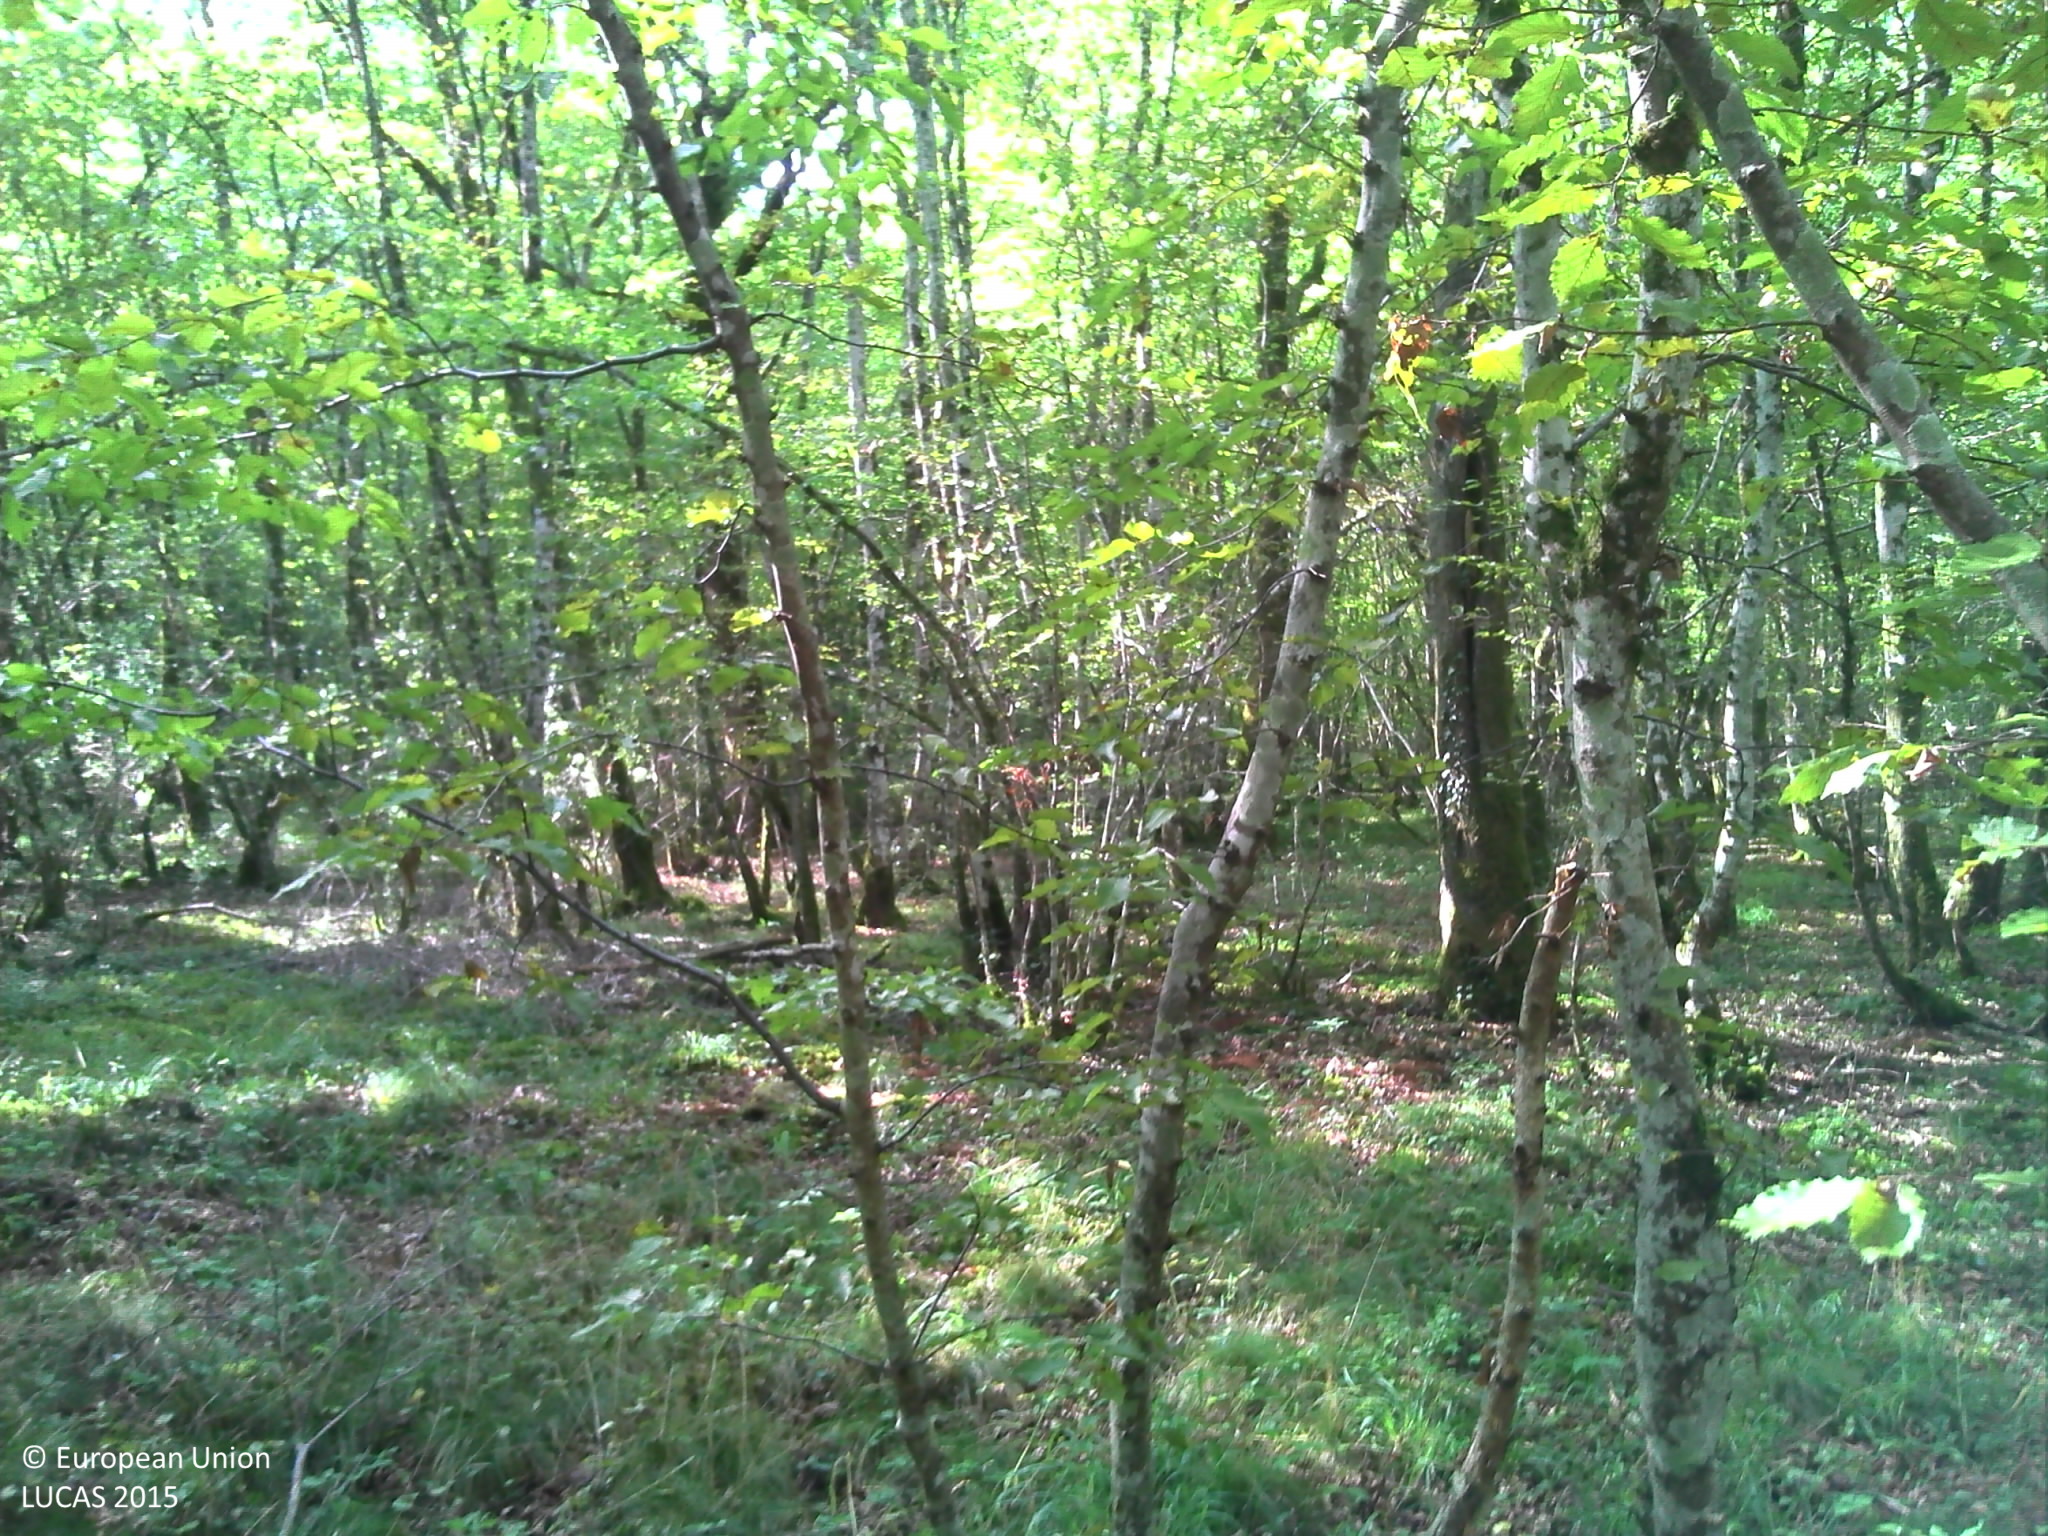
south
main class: Woodland
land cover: Broadleaved woodland
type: mesophytic deciduous forest
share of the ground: > 75 %
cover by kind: broadleaved forest trees 80 %, shrubs 10 %, herbaceous plants 10 %
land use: Forestry
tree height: > 5 m
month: August
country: FR
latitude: 47.2010
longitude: 4.8389
